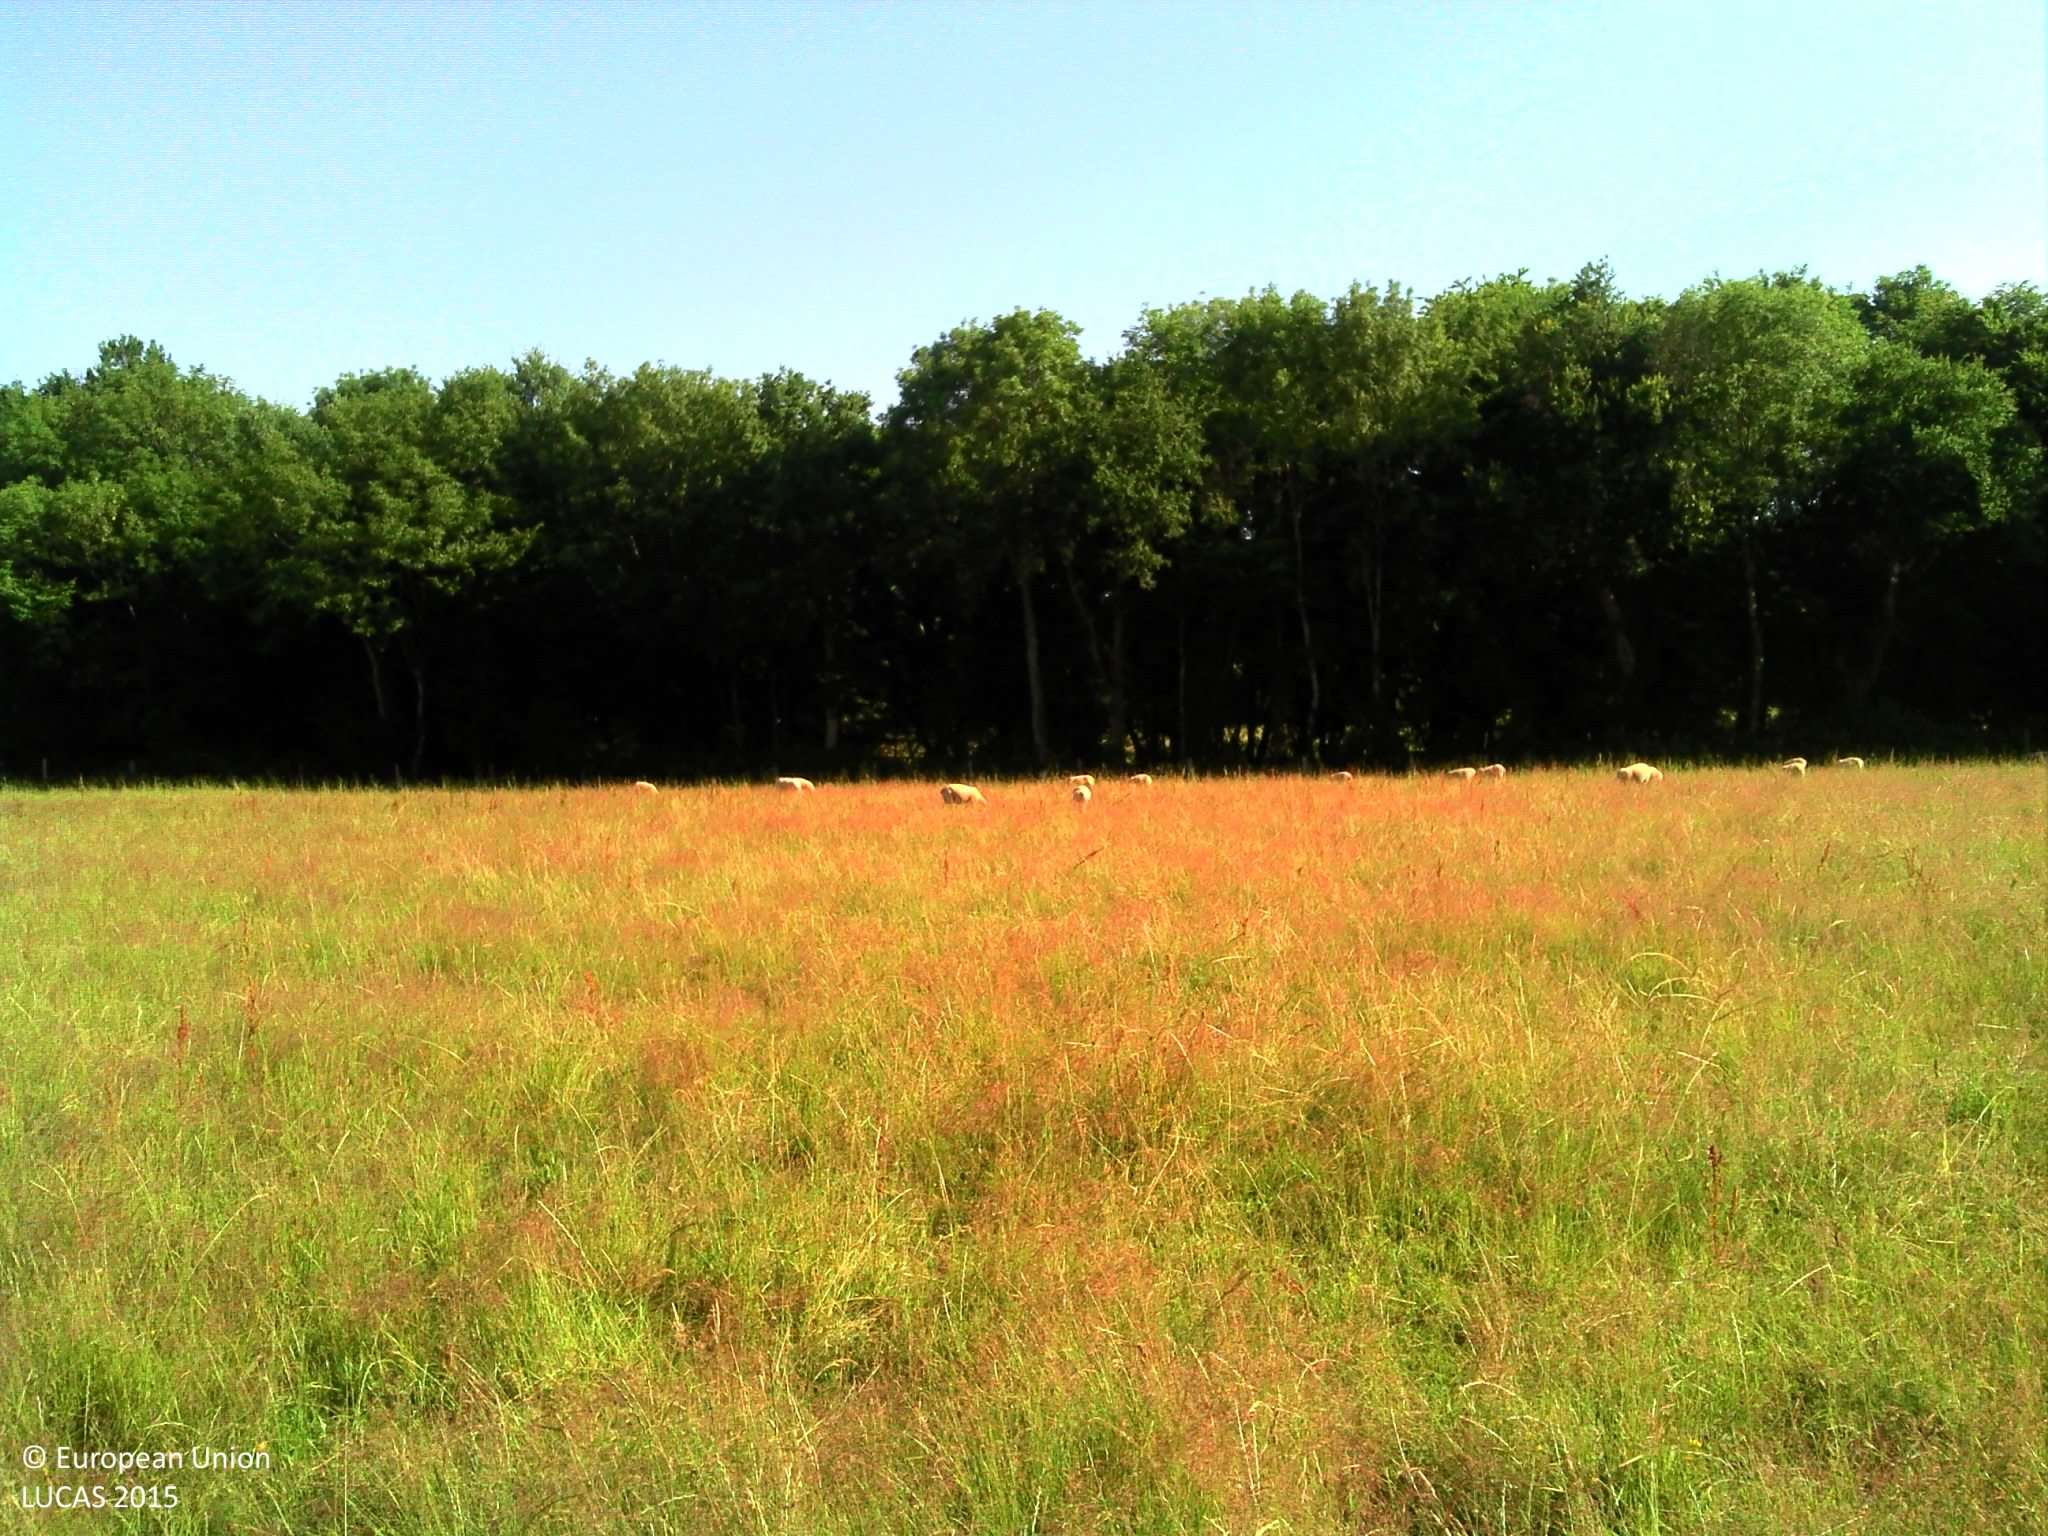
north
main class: Grassland
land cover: Grassland without tree/shrub cover
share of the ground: > 75 %
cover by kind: herbaceous plants 100 %
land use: Agriculture (excluding fallow land and kitchen gardens)
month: June
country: FR
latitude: 45.9217
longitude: 0.6378
